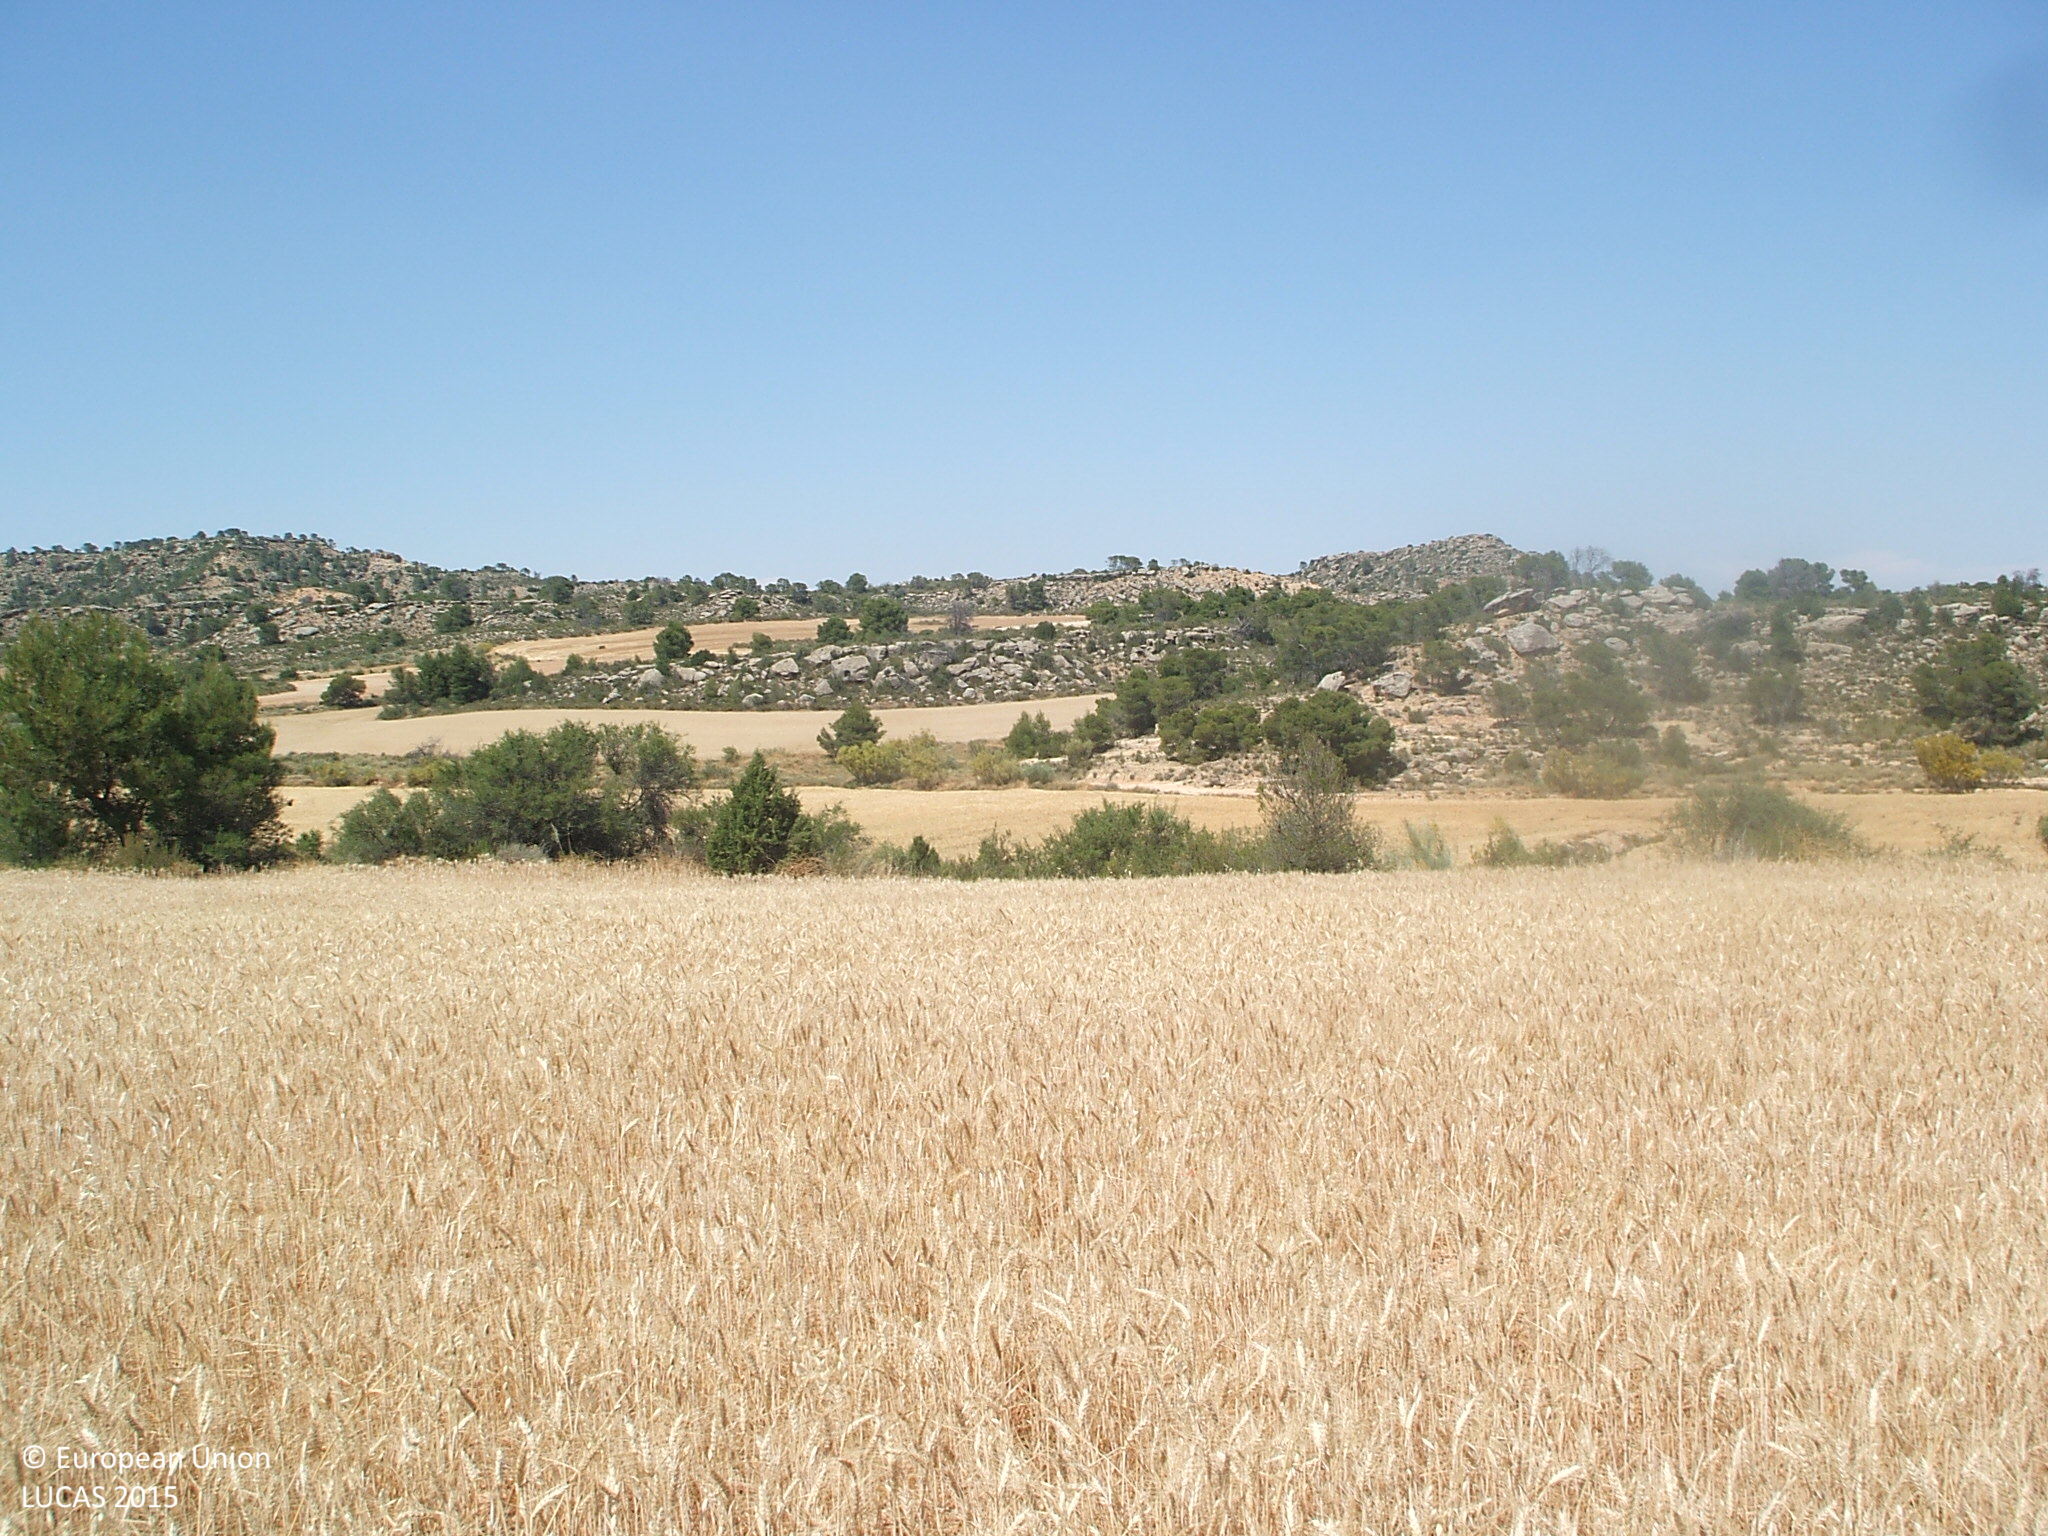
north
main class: Cropland
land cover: Common wheat
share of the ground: > 75 %
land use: Agriculture (excluding fallow land and kitchen gardens)
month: June
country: ES
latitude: 41.0955
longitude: -0.0718
